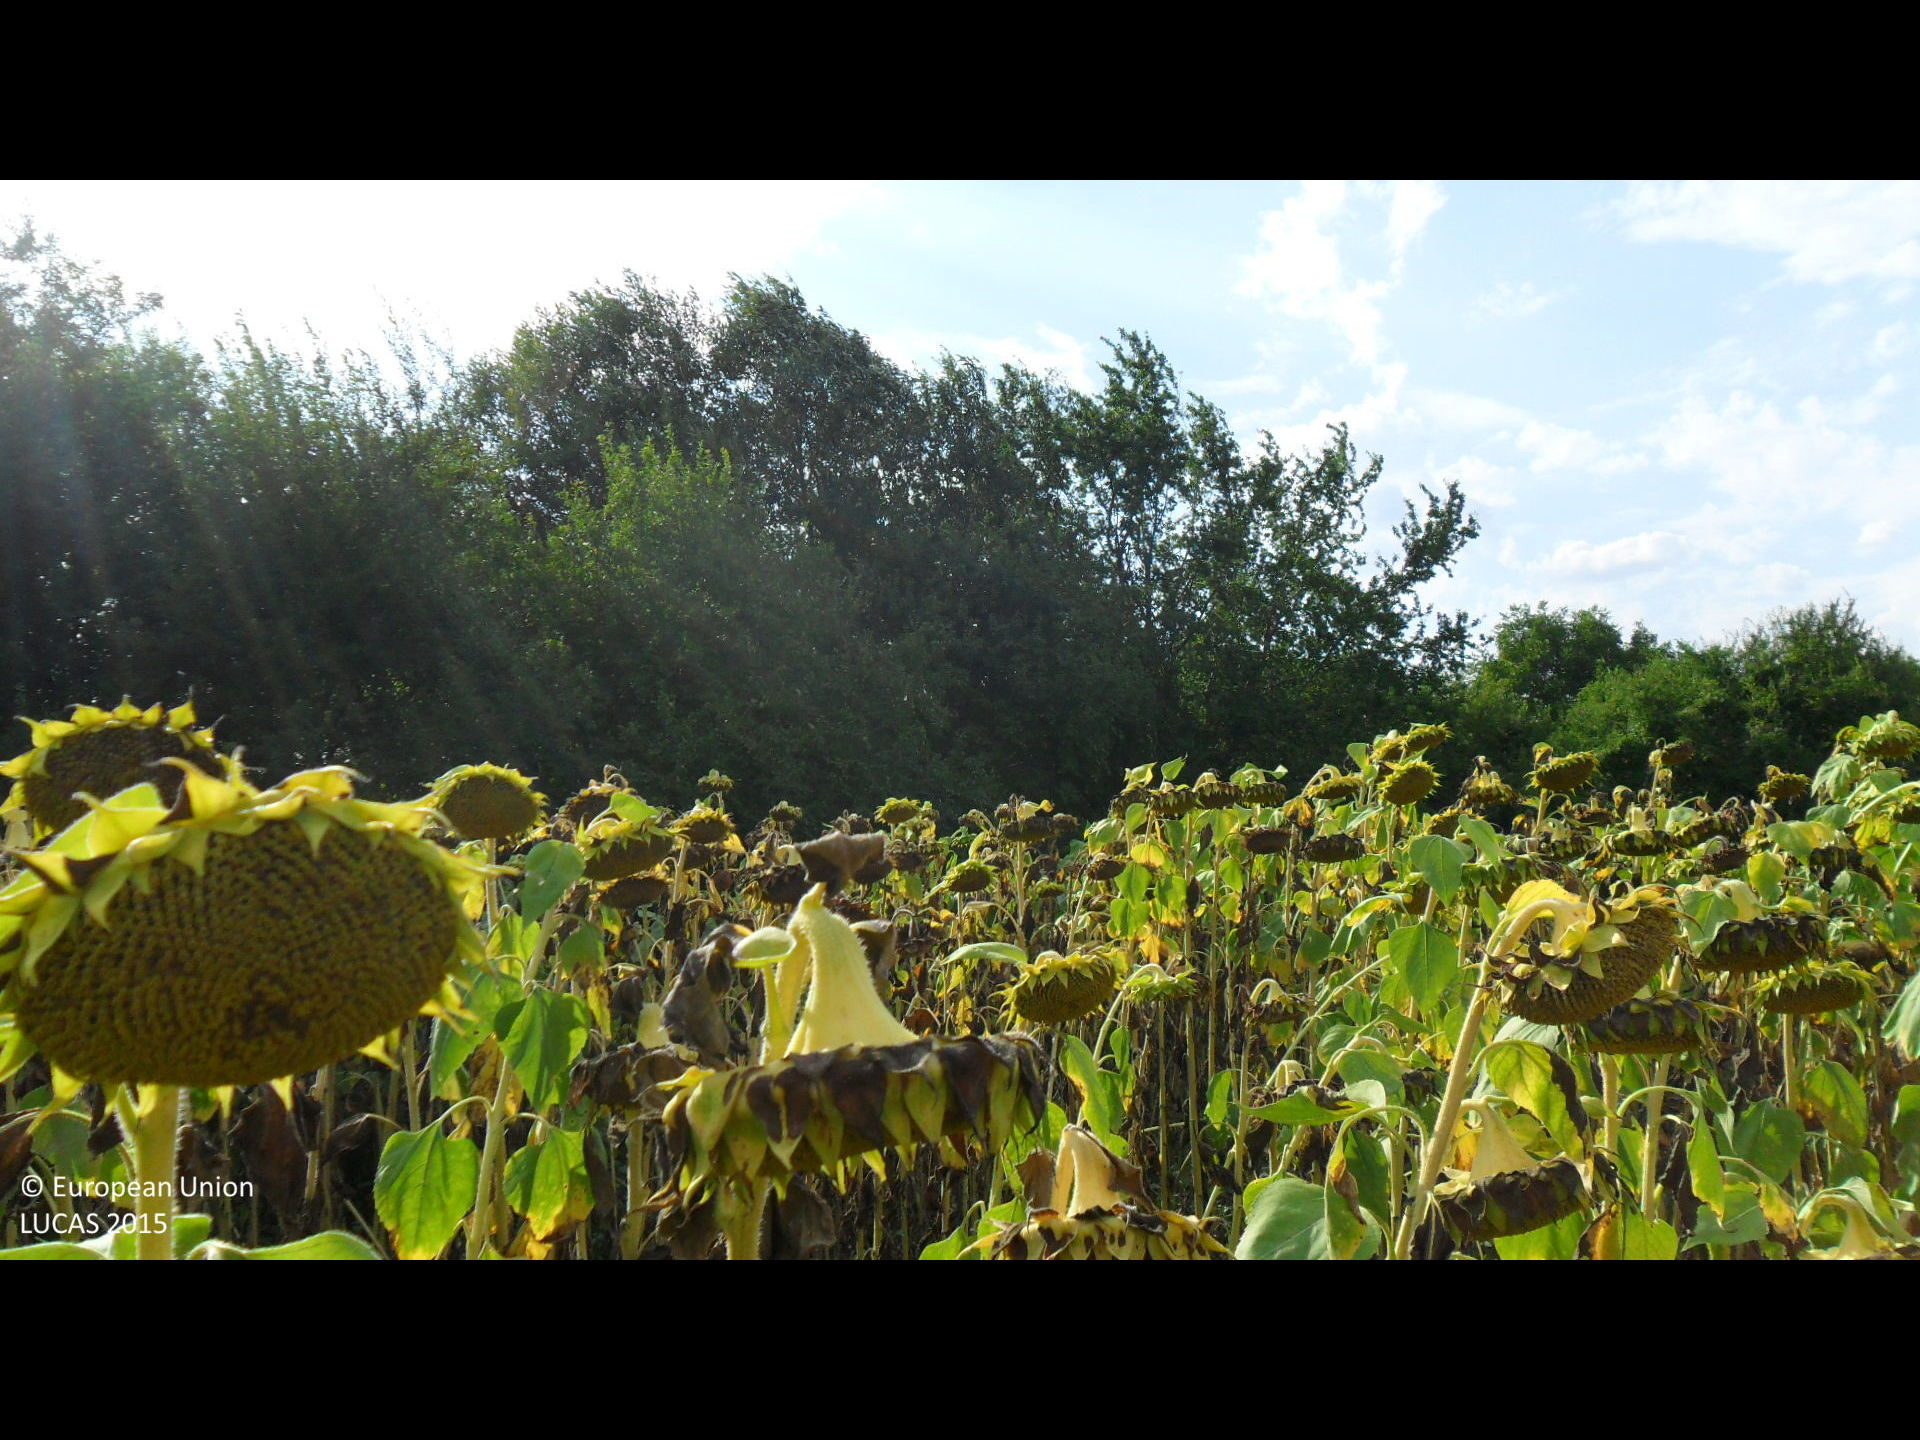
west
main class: Cropland
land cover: Sunflower
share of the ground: > 75 %
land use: Agriculture (excluding fallow land and kitchen gardens)
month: August
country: BG
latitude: 43.3555
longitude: 26.1210
